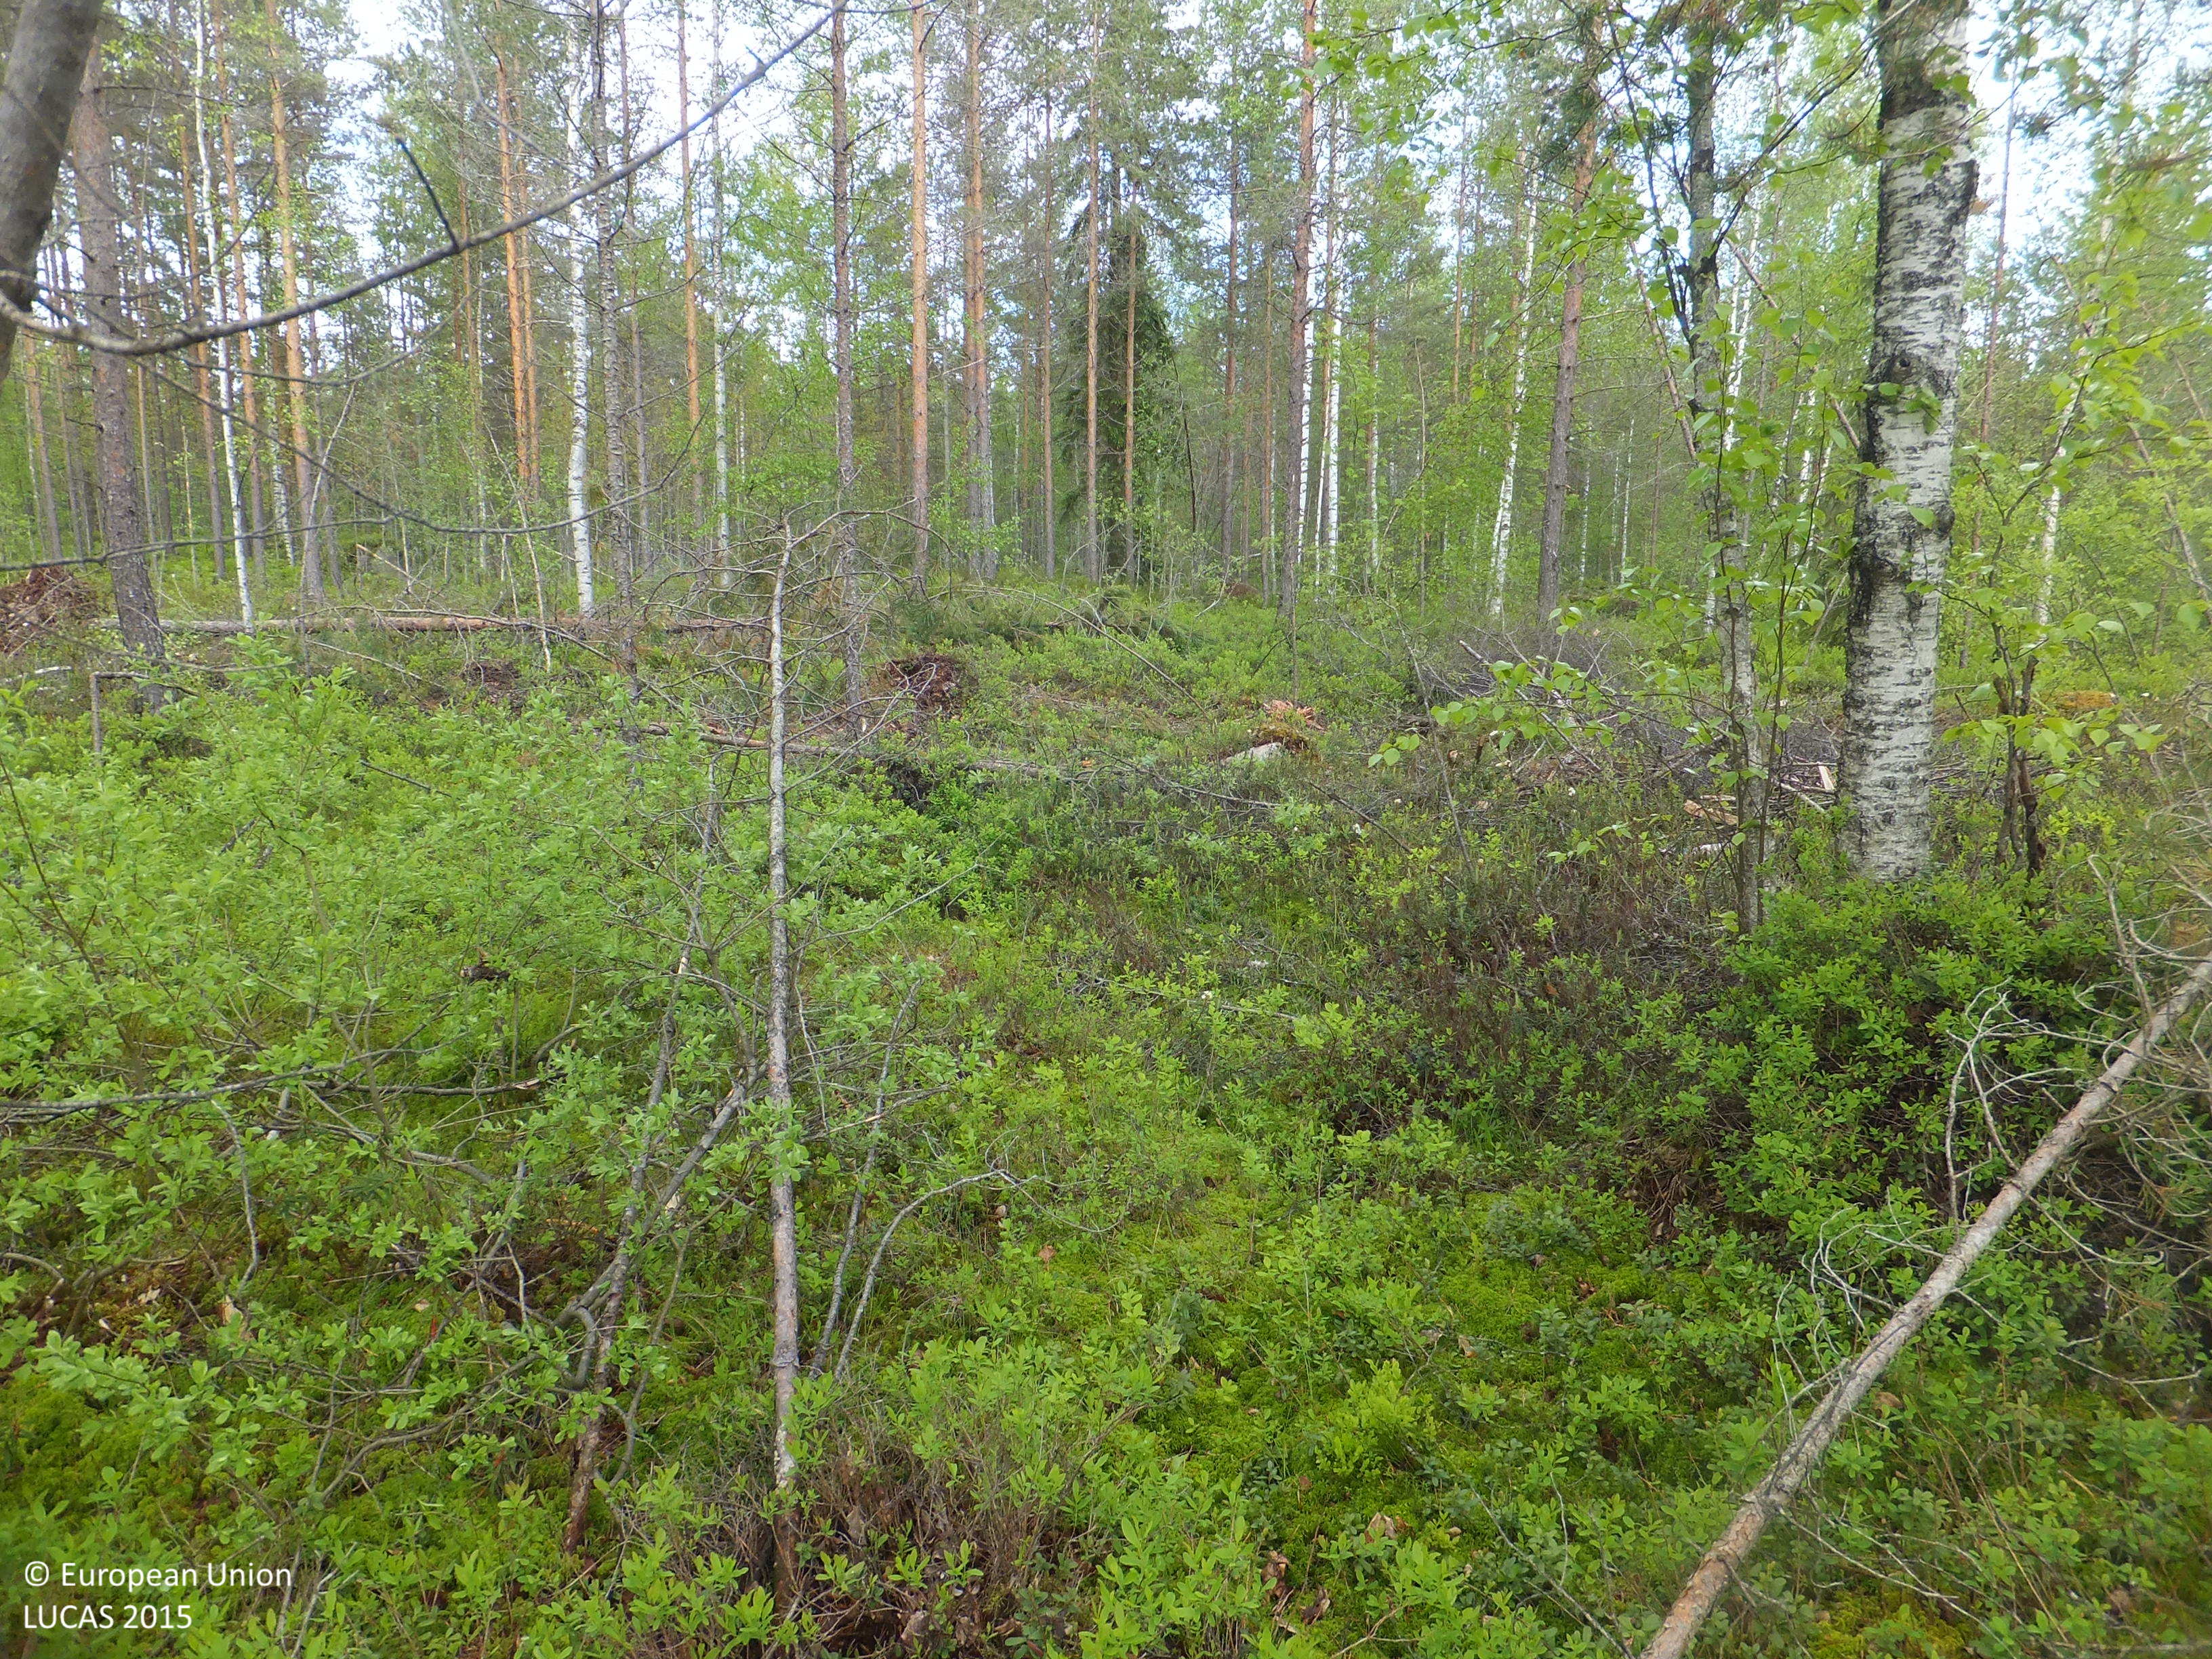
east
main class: Woodland
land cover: Pine dominated mixed woodland
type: boreal forest
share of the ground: 50 - 75 %
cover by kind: coniferous forest trees 35 %, shrubs 35 %, broadleaved forest trees 30 %
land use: Forestry
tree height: > 5 m
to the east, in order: Pine dominated mixed woodland; Tracks; Pine dominated mixed woodland; Electric lines; Other coniferous woodland; Other mixed woodland; Ditches and canals; Temporary grasslands
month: June
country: FI
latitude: 63.5797
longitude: 23.9069
